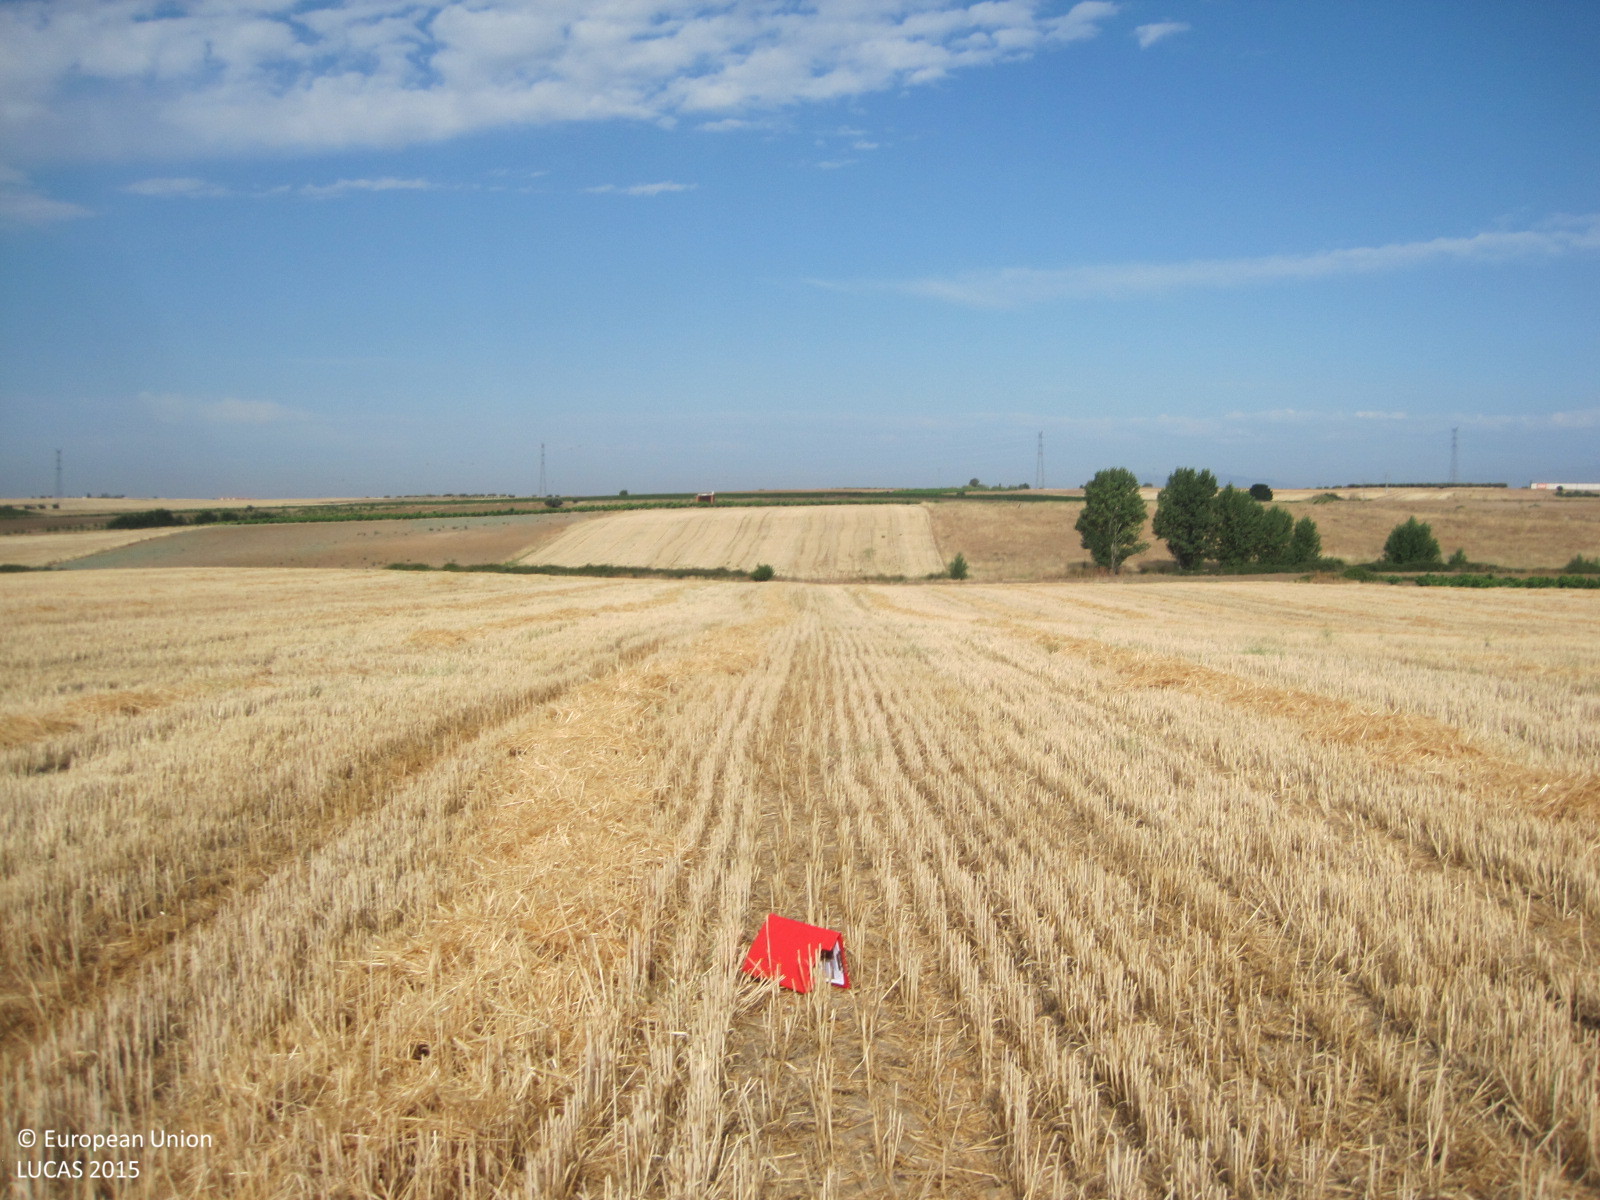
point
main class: Cropland
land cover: Common wheat
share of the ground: < 10 %
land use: Agriculture (excluding fallow land and kitchen gardens)
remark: Harvested field
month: July
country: ES
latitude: 40.0487
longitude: -4.2348
